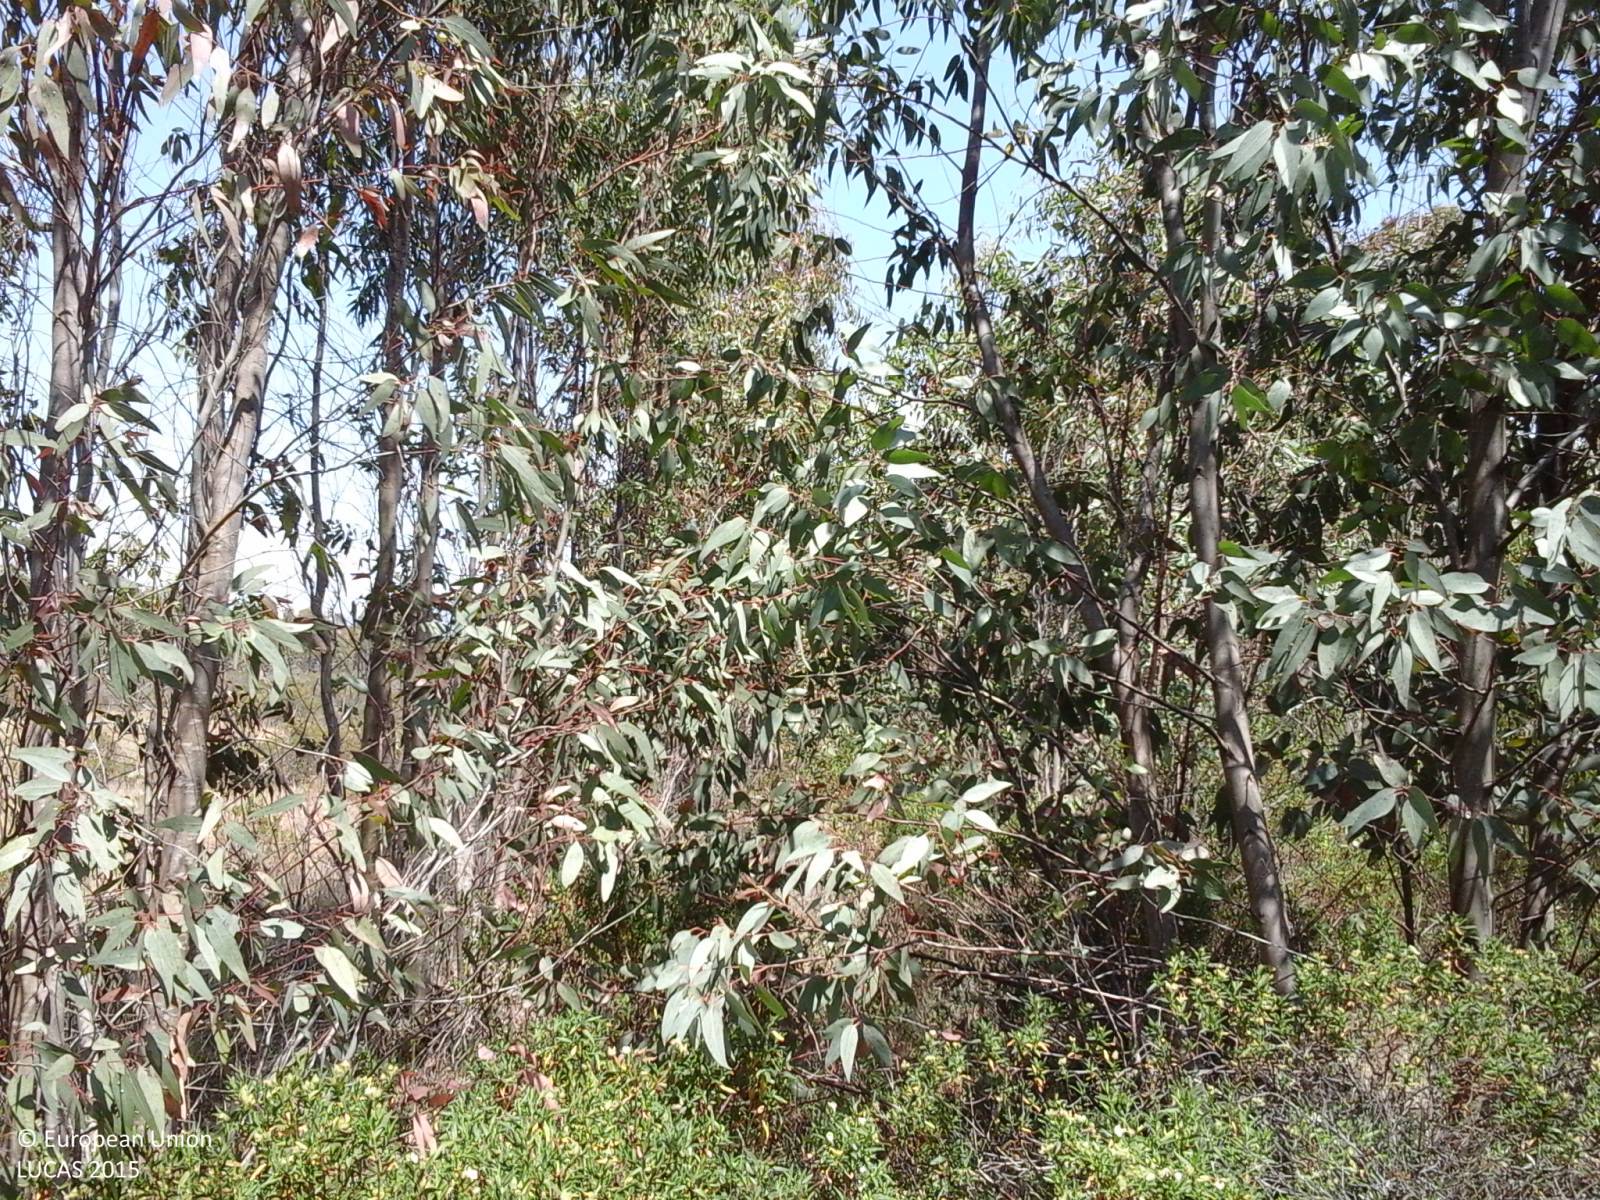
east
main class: Woodland
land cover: Broadleaved woodland
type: exotic forest
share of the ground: > 75 %
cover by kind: broadleaved forest trees 100 %
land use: Forestry
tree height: < 5 m
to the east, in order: Broadleaved woodland; Fences; Railways; Fences; Grassland without tree/shrub cover
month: May
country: IT
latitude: 39.7871
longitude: 8.6415
